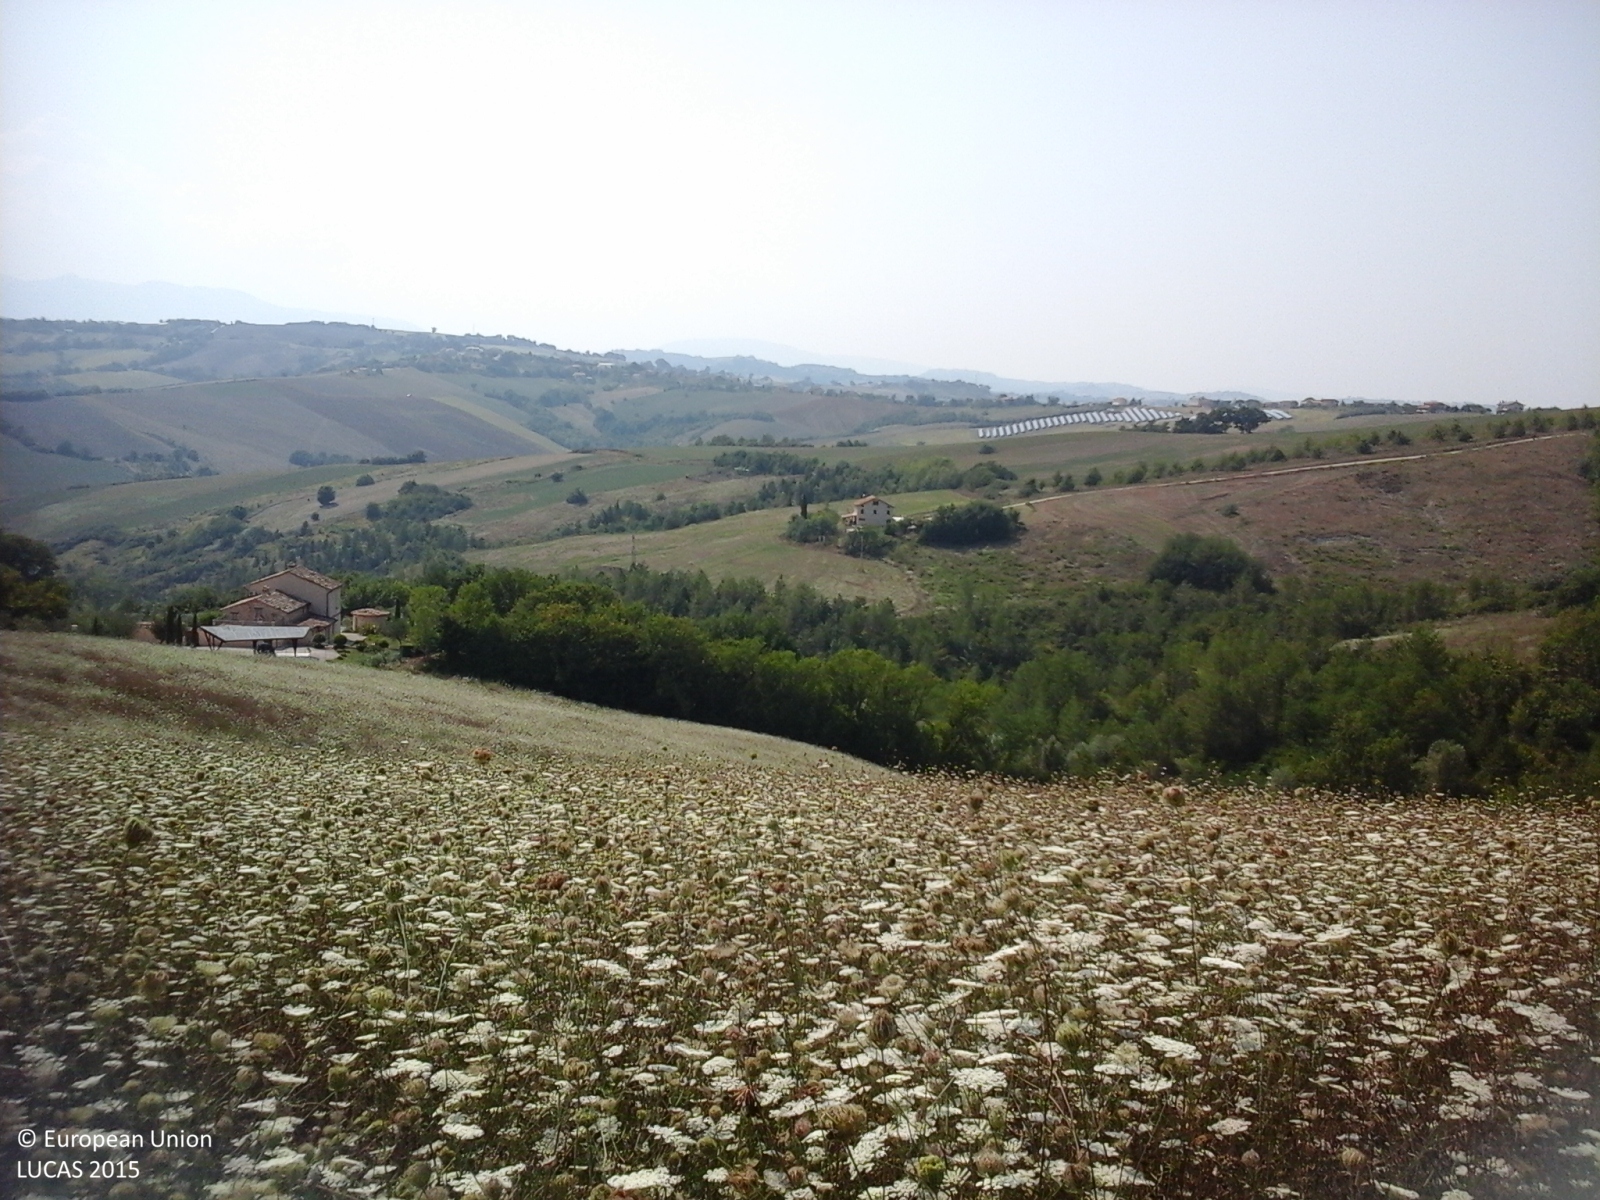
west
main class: Grassland
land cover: Spontaneously vegetated surfaces
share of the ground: > 75 %
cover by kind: herbaceous plants 100 %
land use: Fallow land
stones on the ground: < 10 %
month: August
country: IT
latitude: 43.1007
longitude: 13.4678
